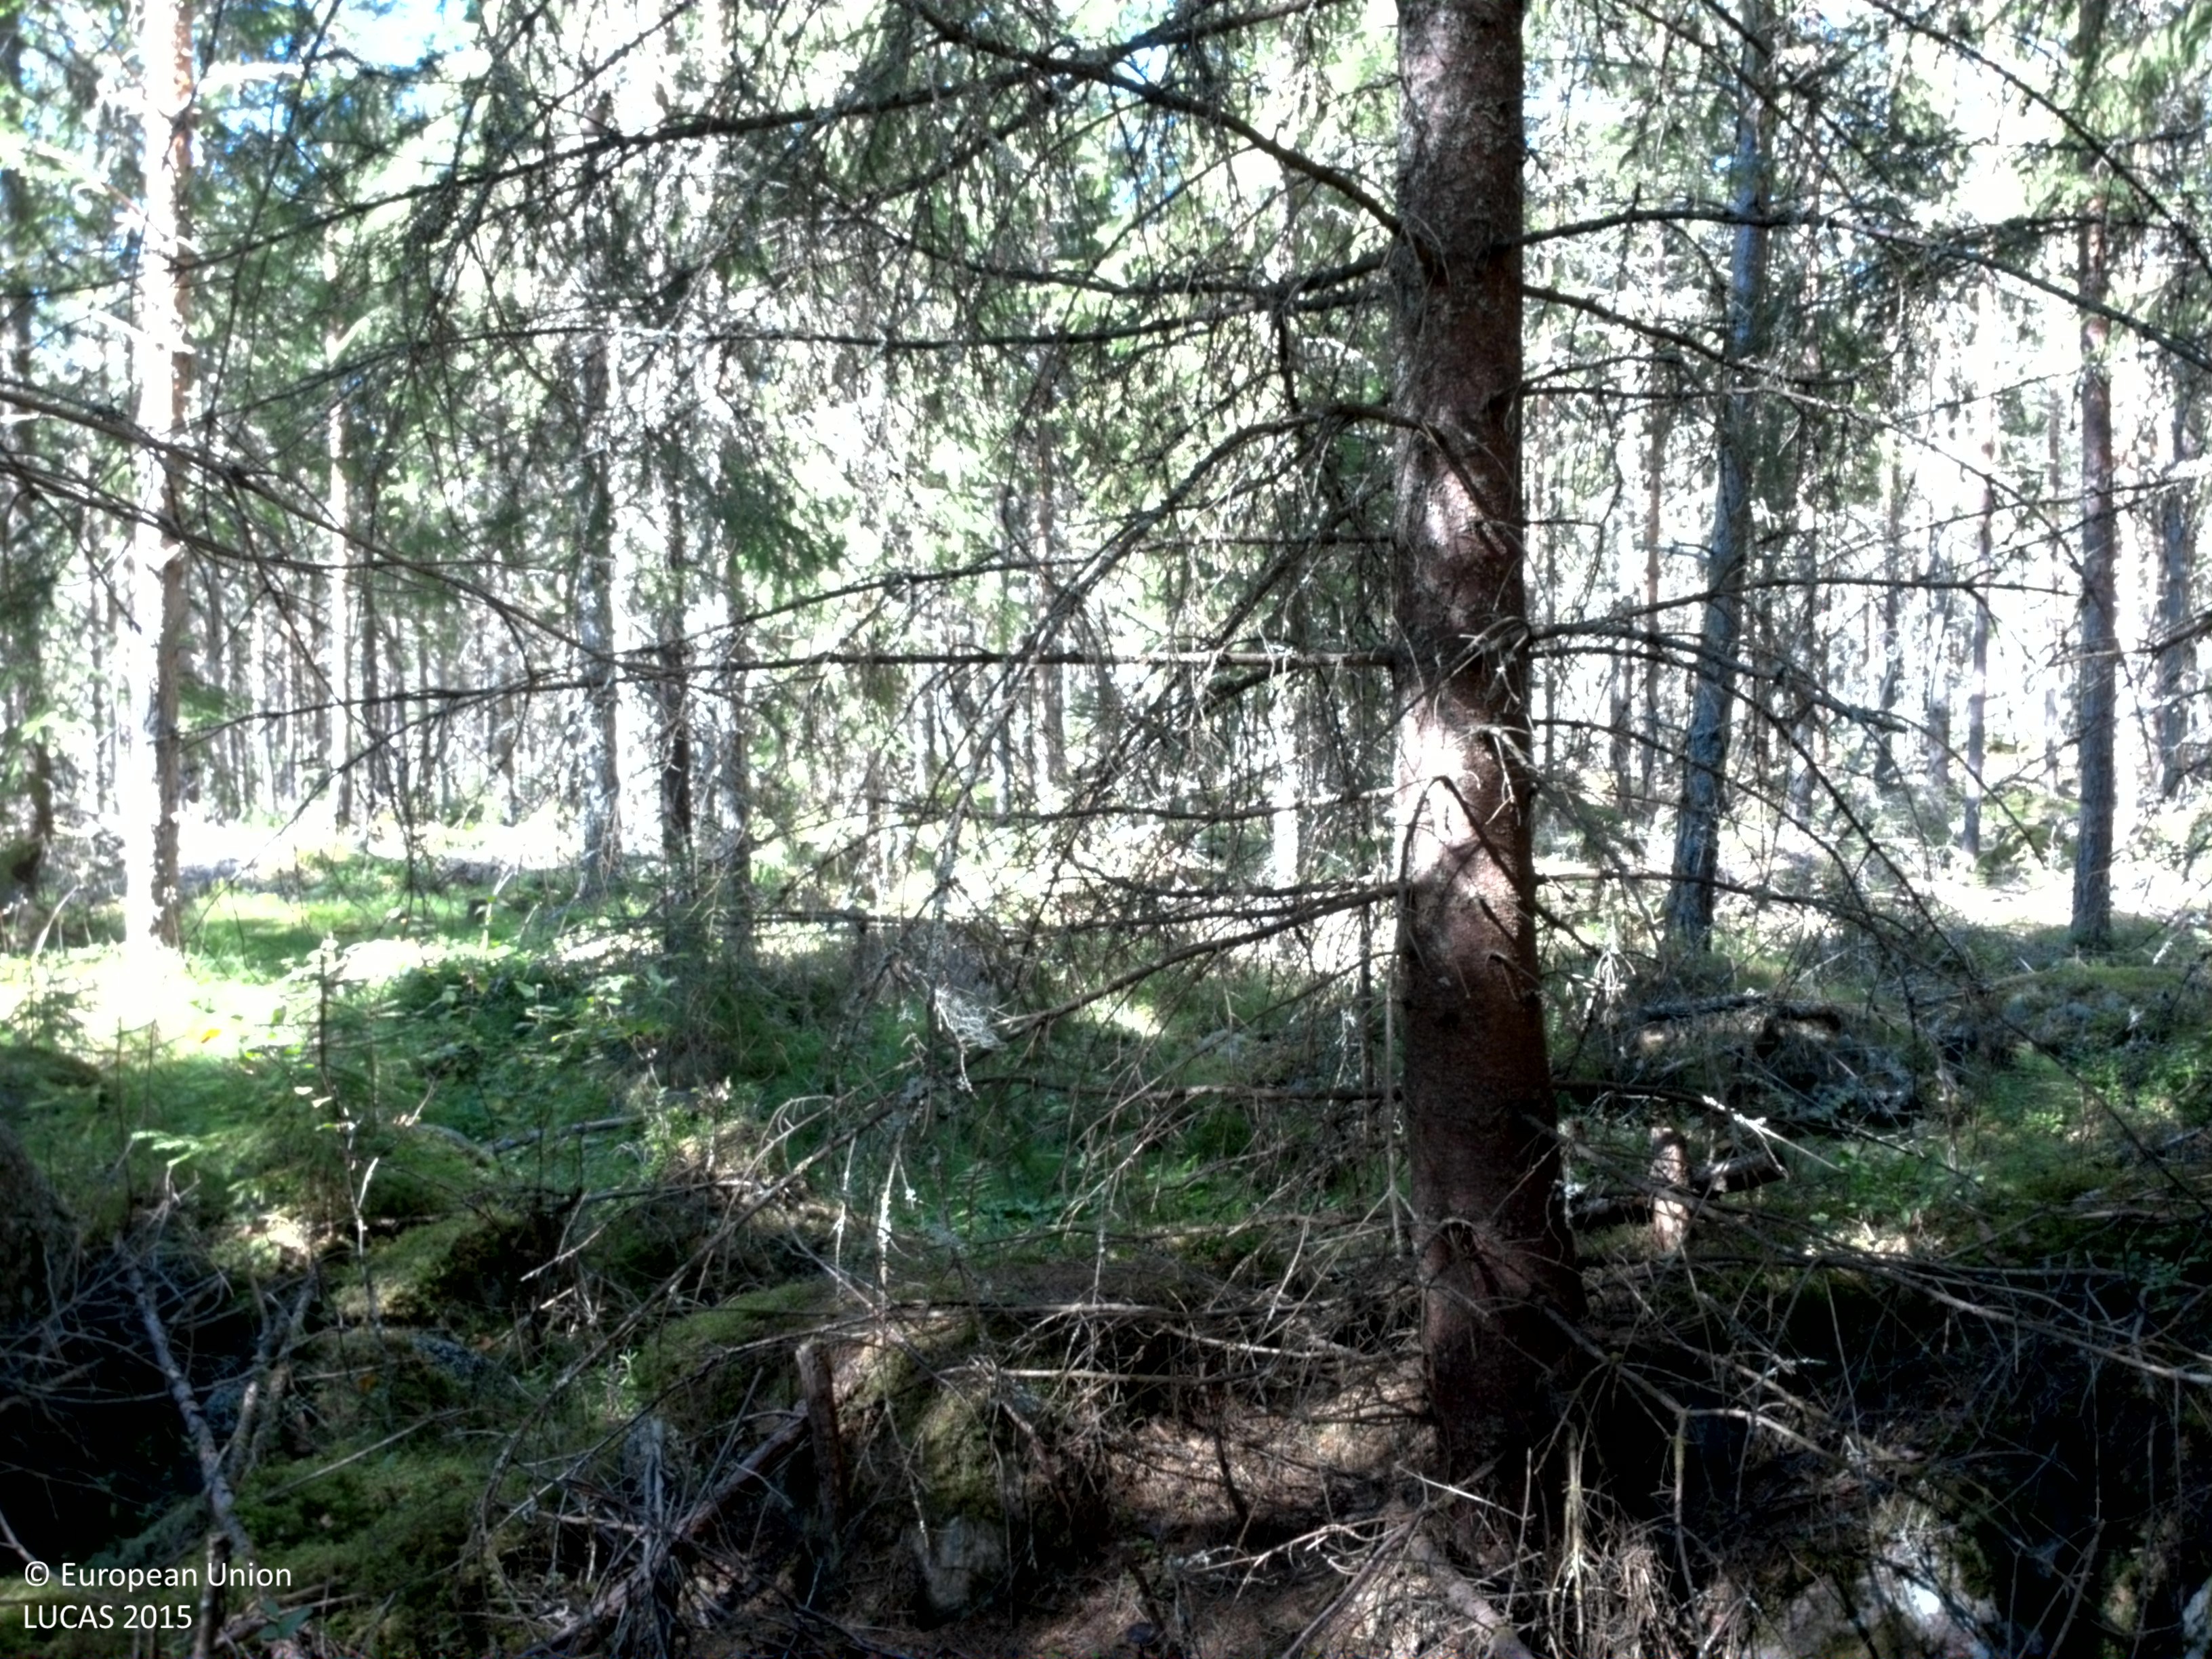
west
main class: Woodland
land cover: Spruce dominated coniferous woodland
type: boreal forest
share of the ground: 50 - 75 %
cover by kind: coniferous forest trees 60 %, lichens and mosses 30 %, shrubs 10 %
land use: Forestry
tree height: > 5 m
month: August
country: SE
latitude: 60.0824
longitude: 13.5316
